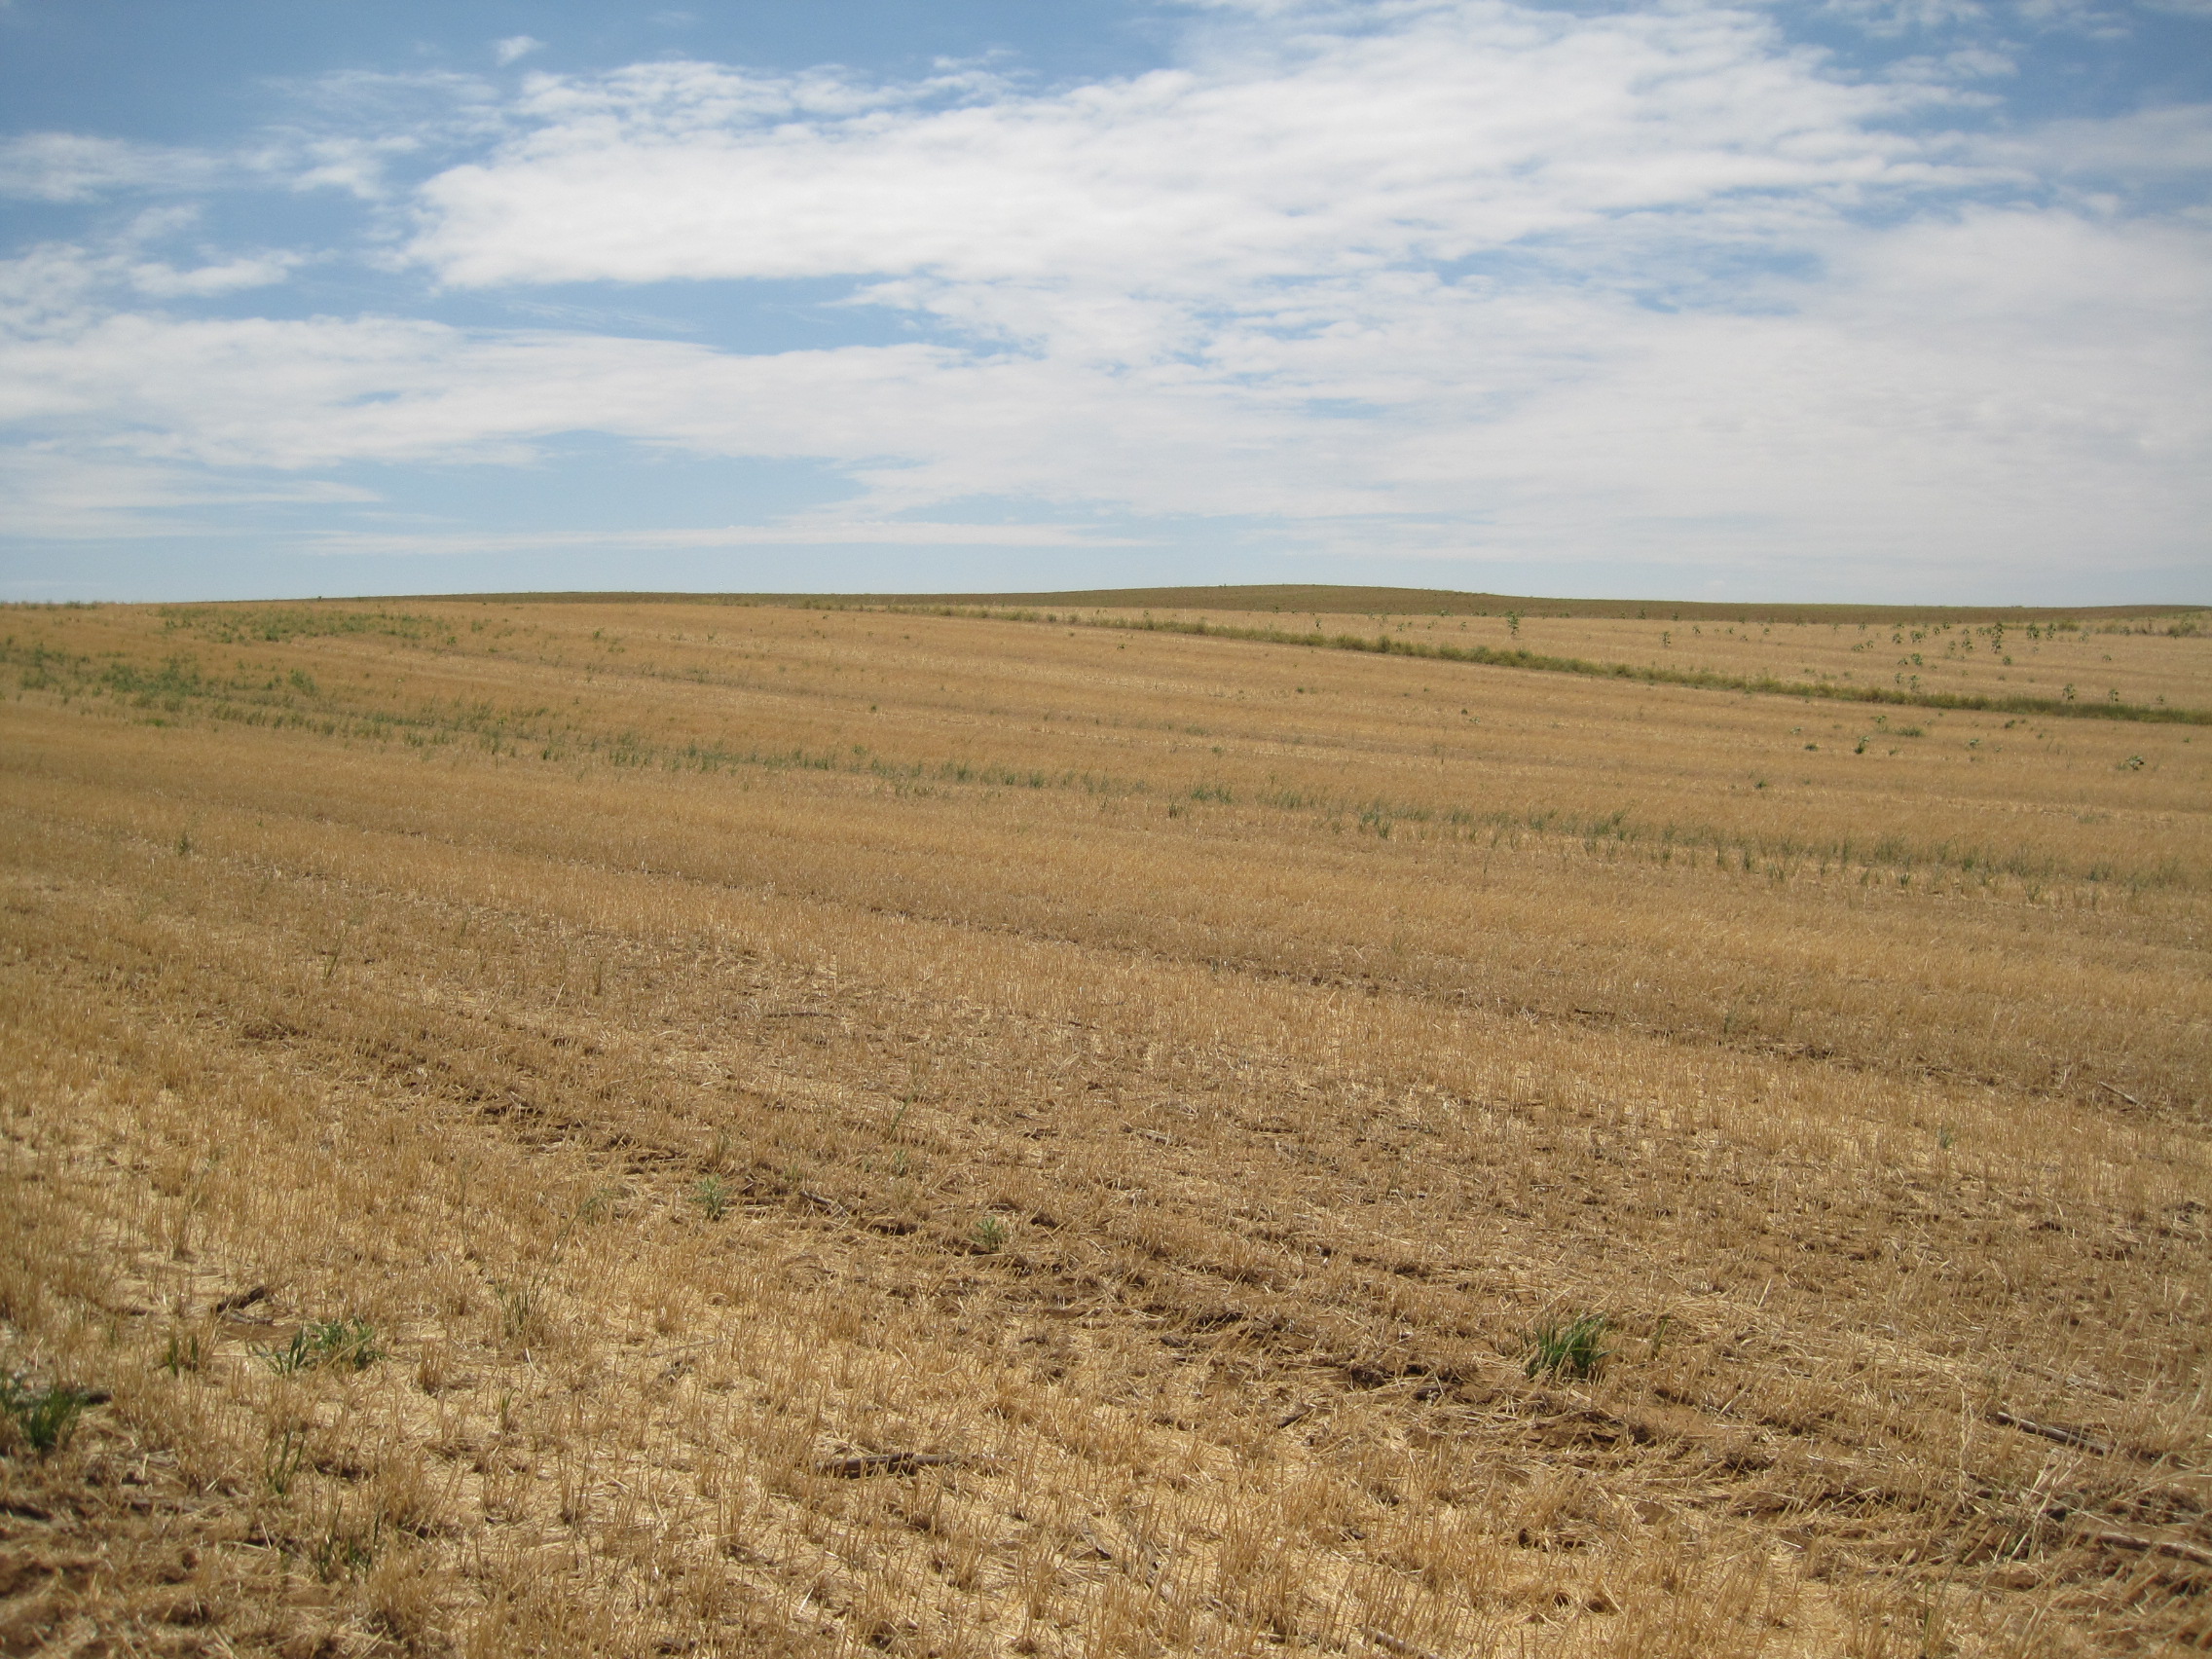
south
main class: Cropland
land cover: Barley
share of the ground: < 10 %
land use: Agriculture (excluding fallow land and kitchen gardens)
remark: Harvested field
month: July
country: ES
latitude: 42.0498
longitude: -5.1977
